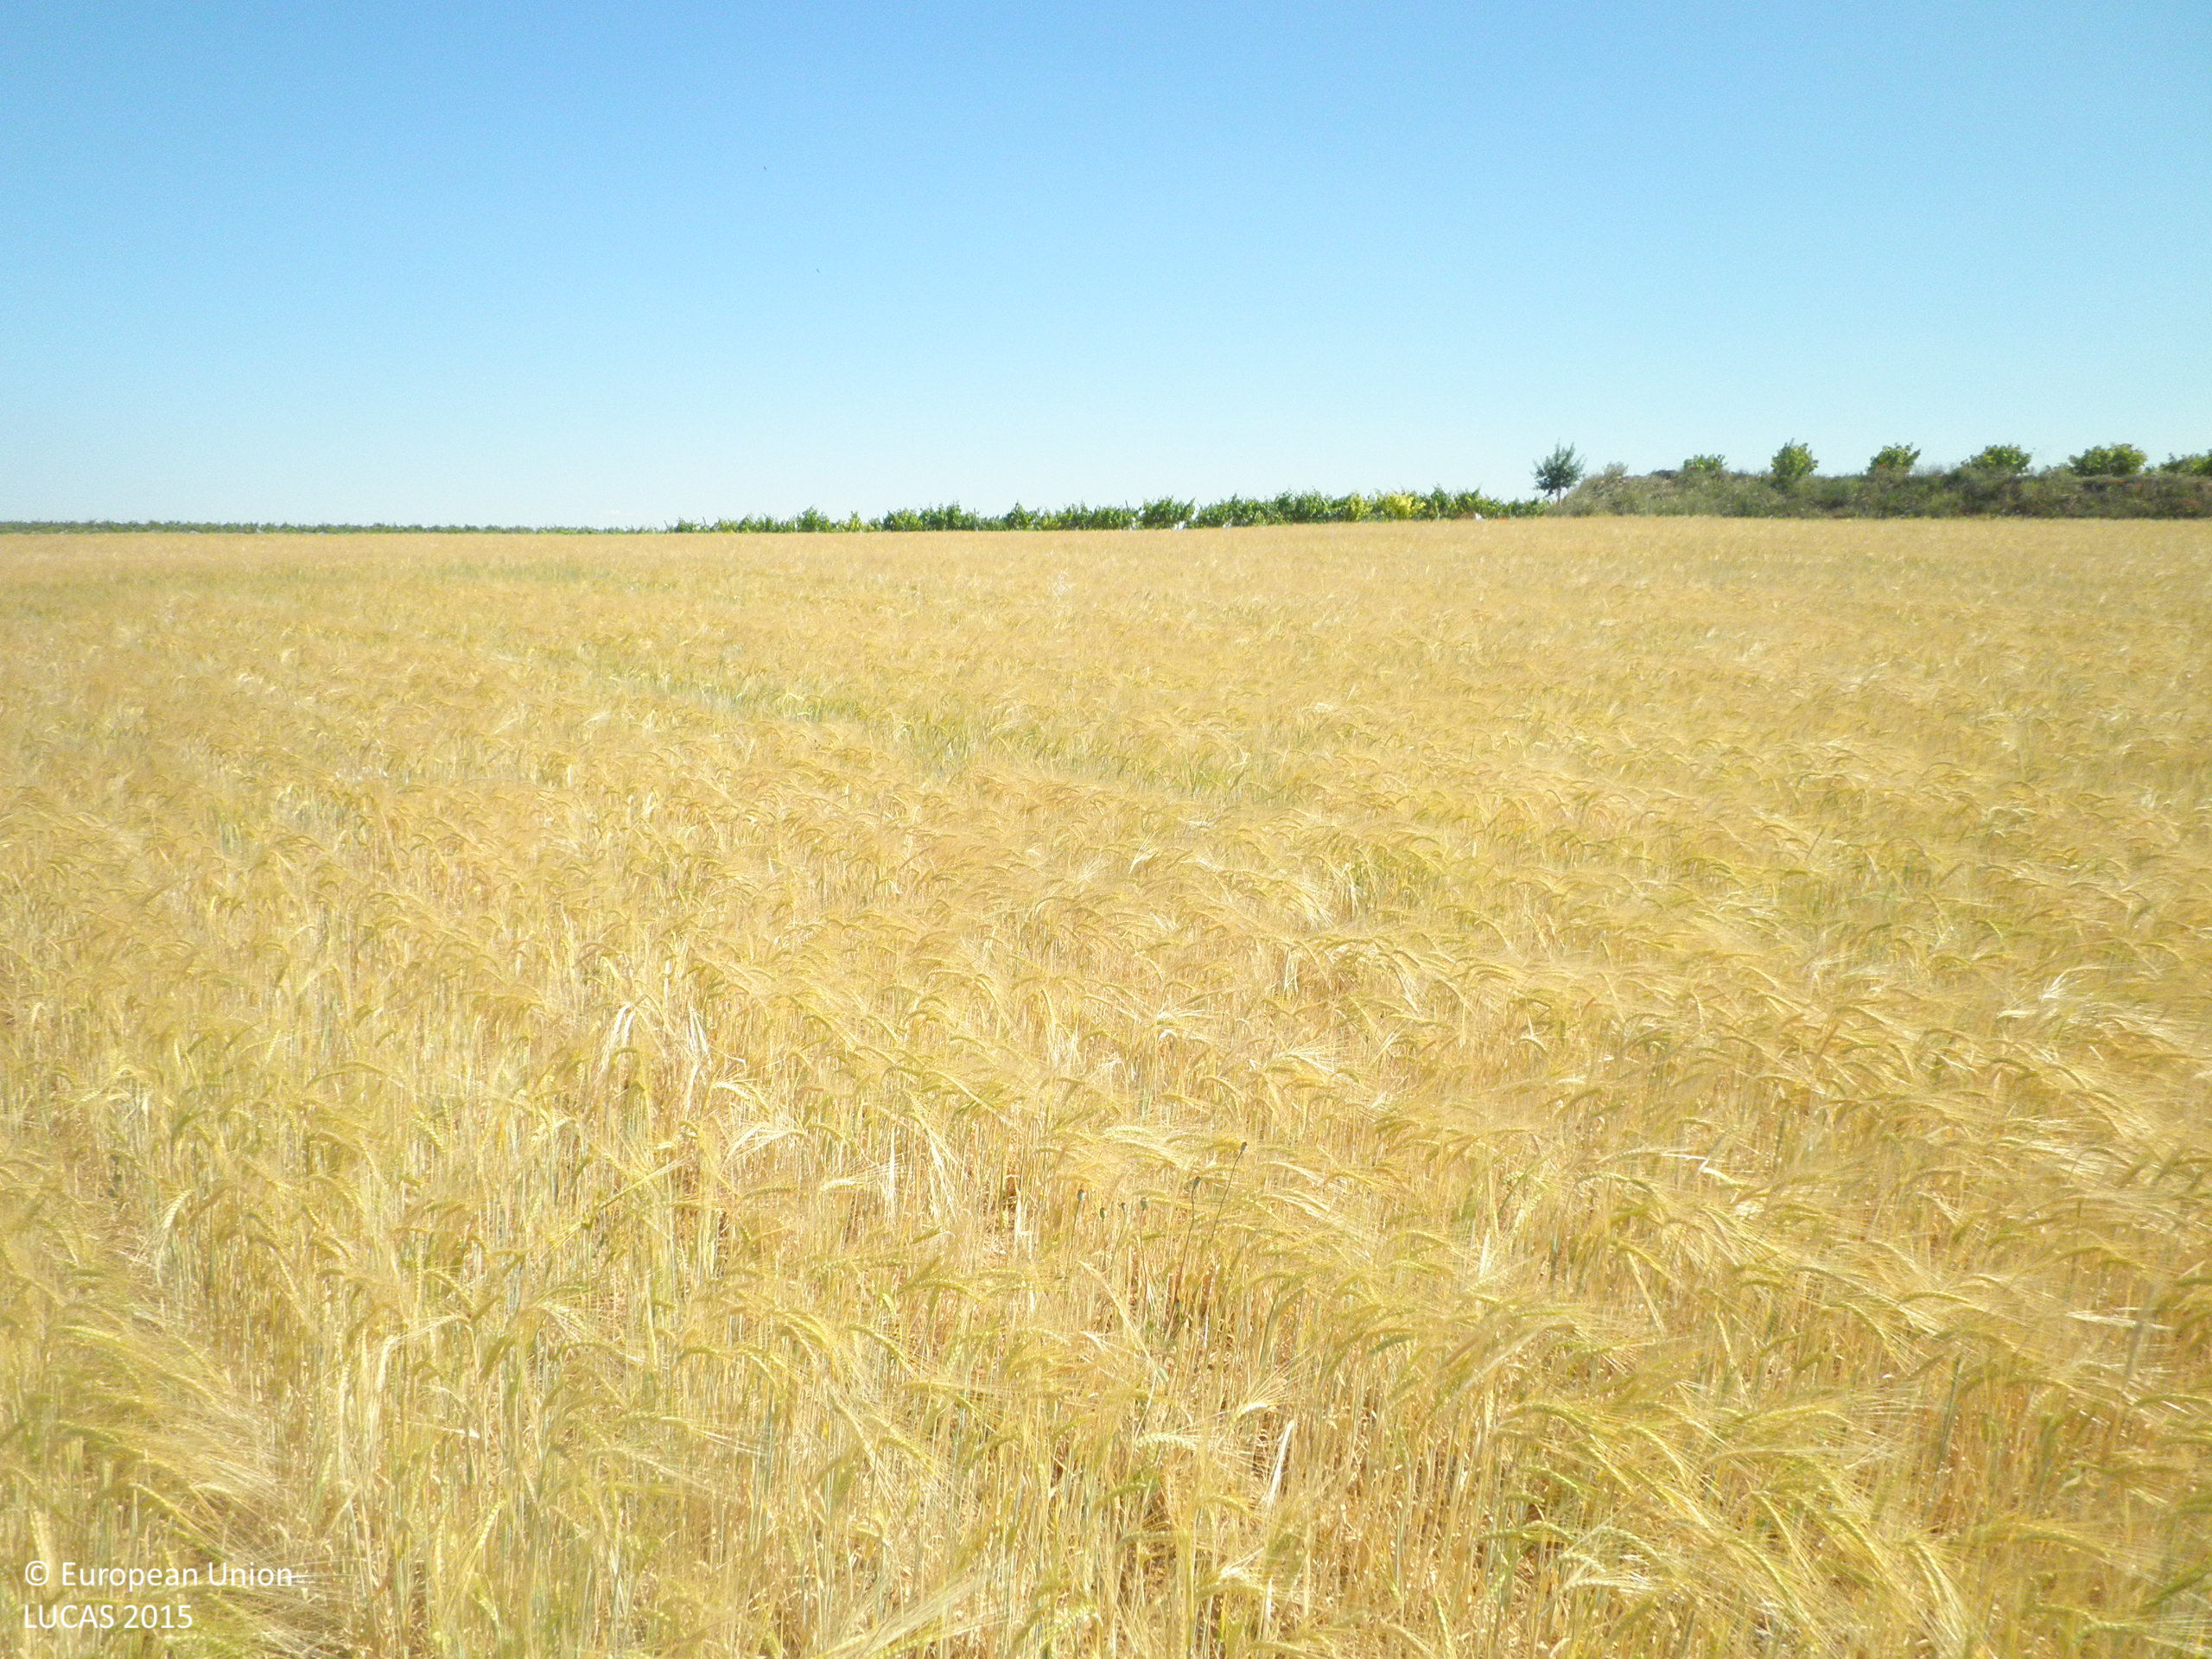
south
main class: Cropland
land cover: Barley
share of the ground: > 75 %
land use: Agriculture (excluding fallow land and kitchen gardens)
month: June
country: ES
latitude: 39.4073
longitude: -1.7928
